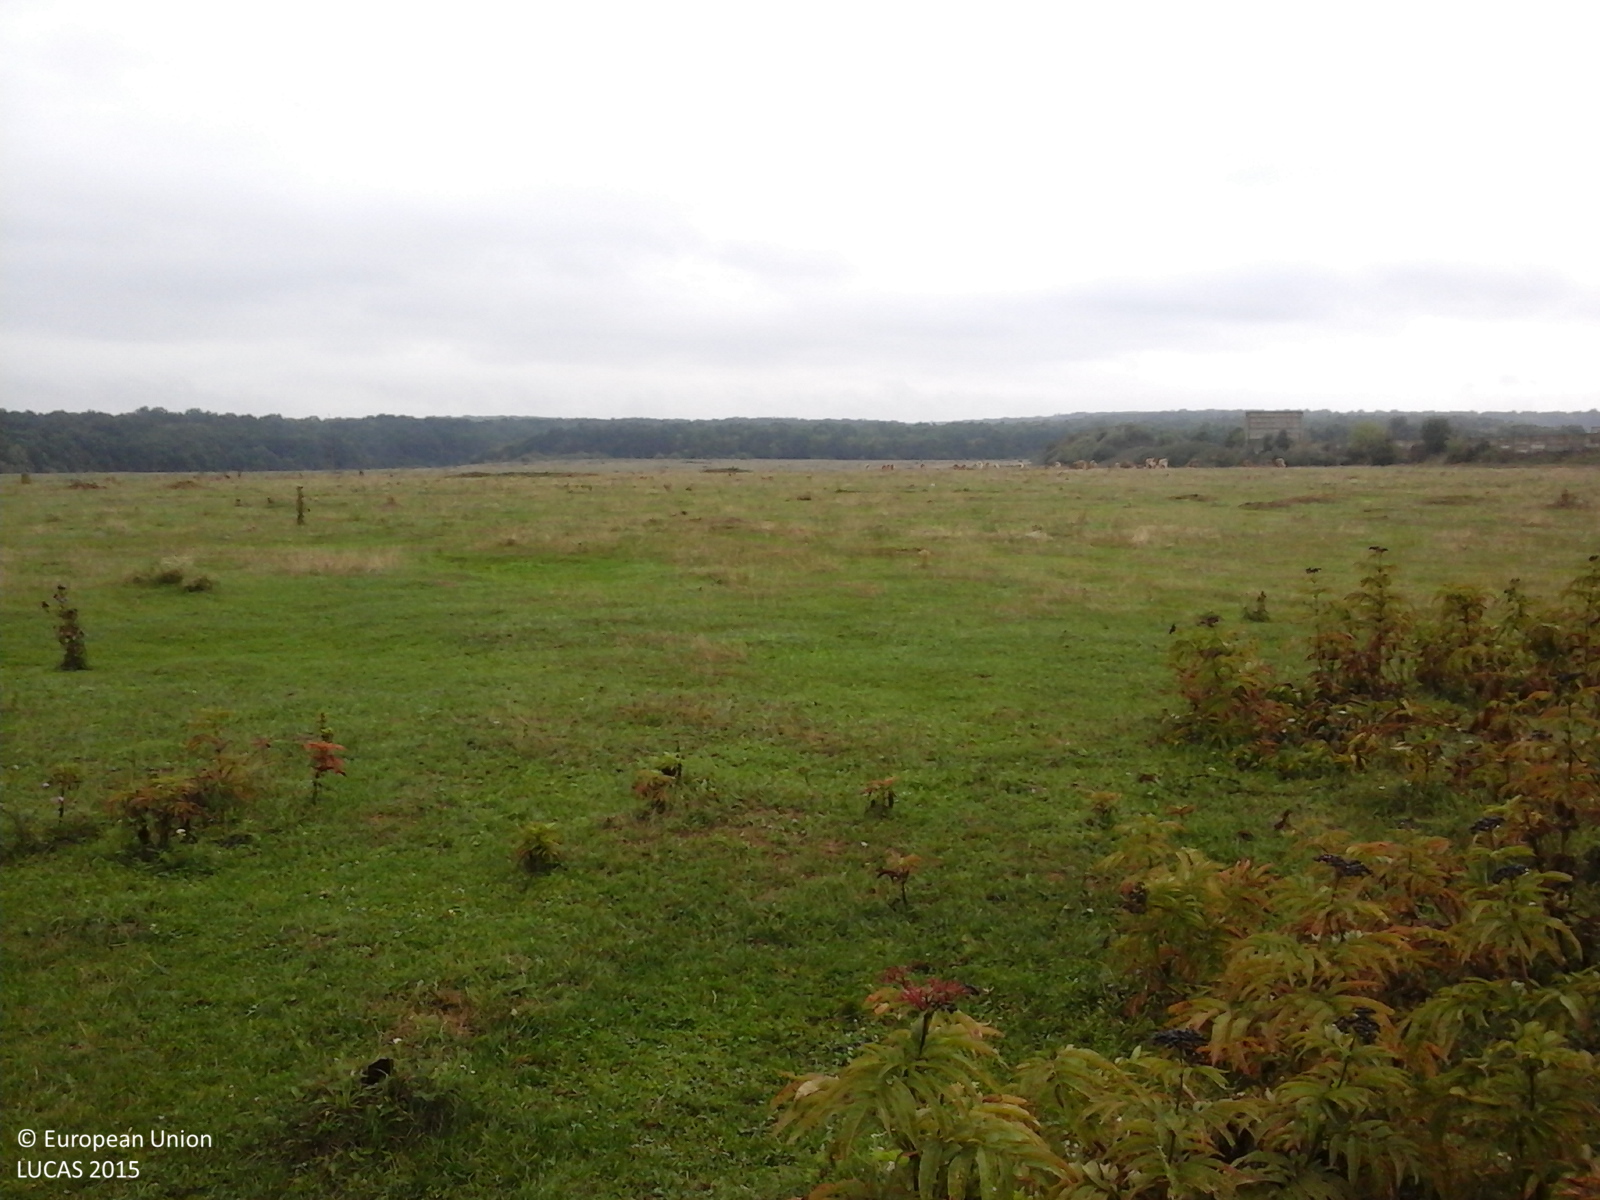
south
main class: Grassland
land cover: Grassland without tree/shrub cover
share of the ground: > 75 %
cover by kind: herbaceous plants 100 %
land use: Agriculture (excluding fallow land and kitchen gardens)
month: September
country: RO
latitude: 46.9892
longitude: 21.9456
